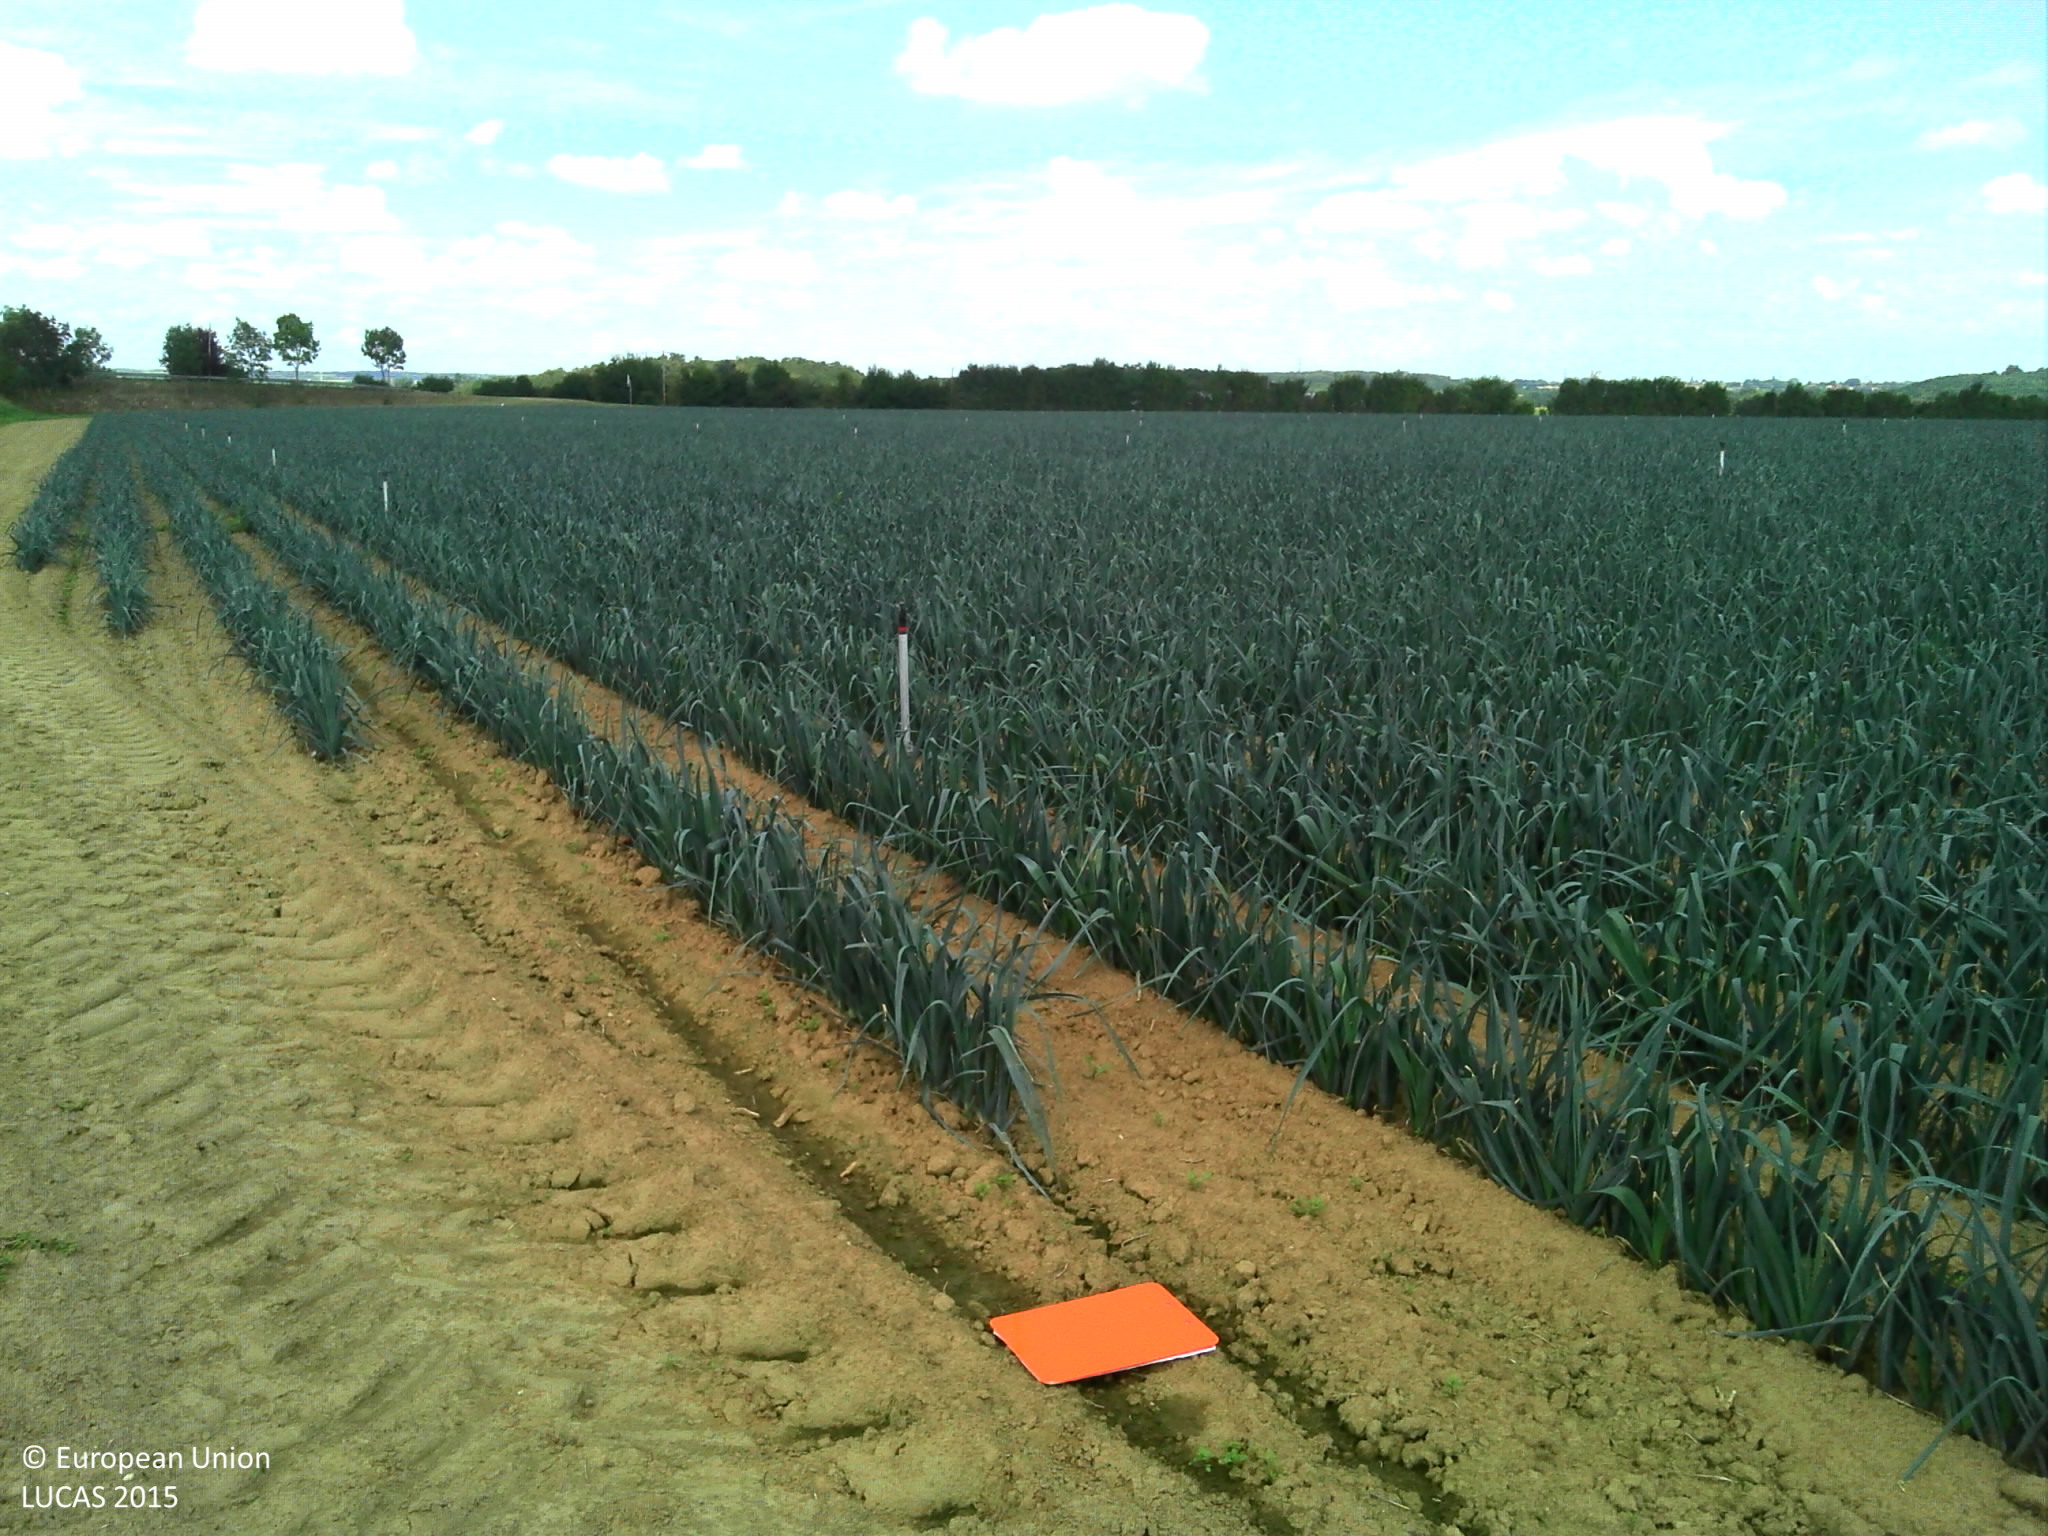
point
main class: Cropland
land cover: Other fresh vegetables
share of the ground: 10 - 25 %
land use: Agriculture (excluding fallow land and kitchen gardens)
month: August
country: FR
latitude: 45.8334
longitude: 4.9183
